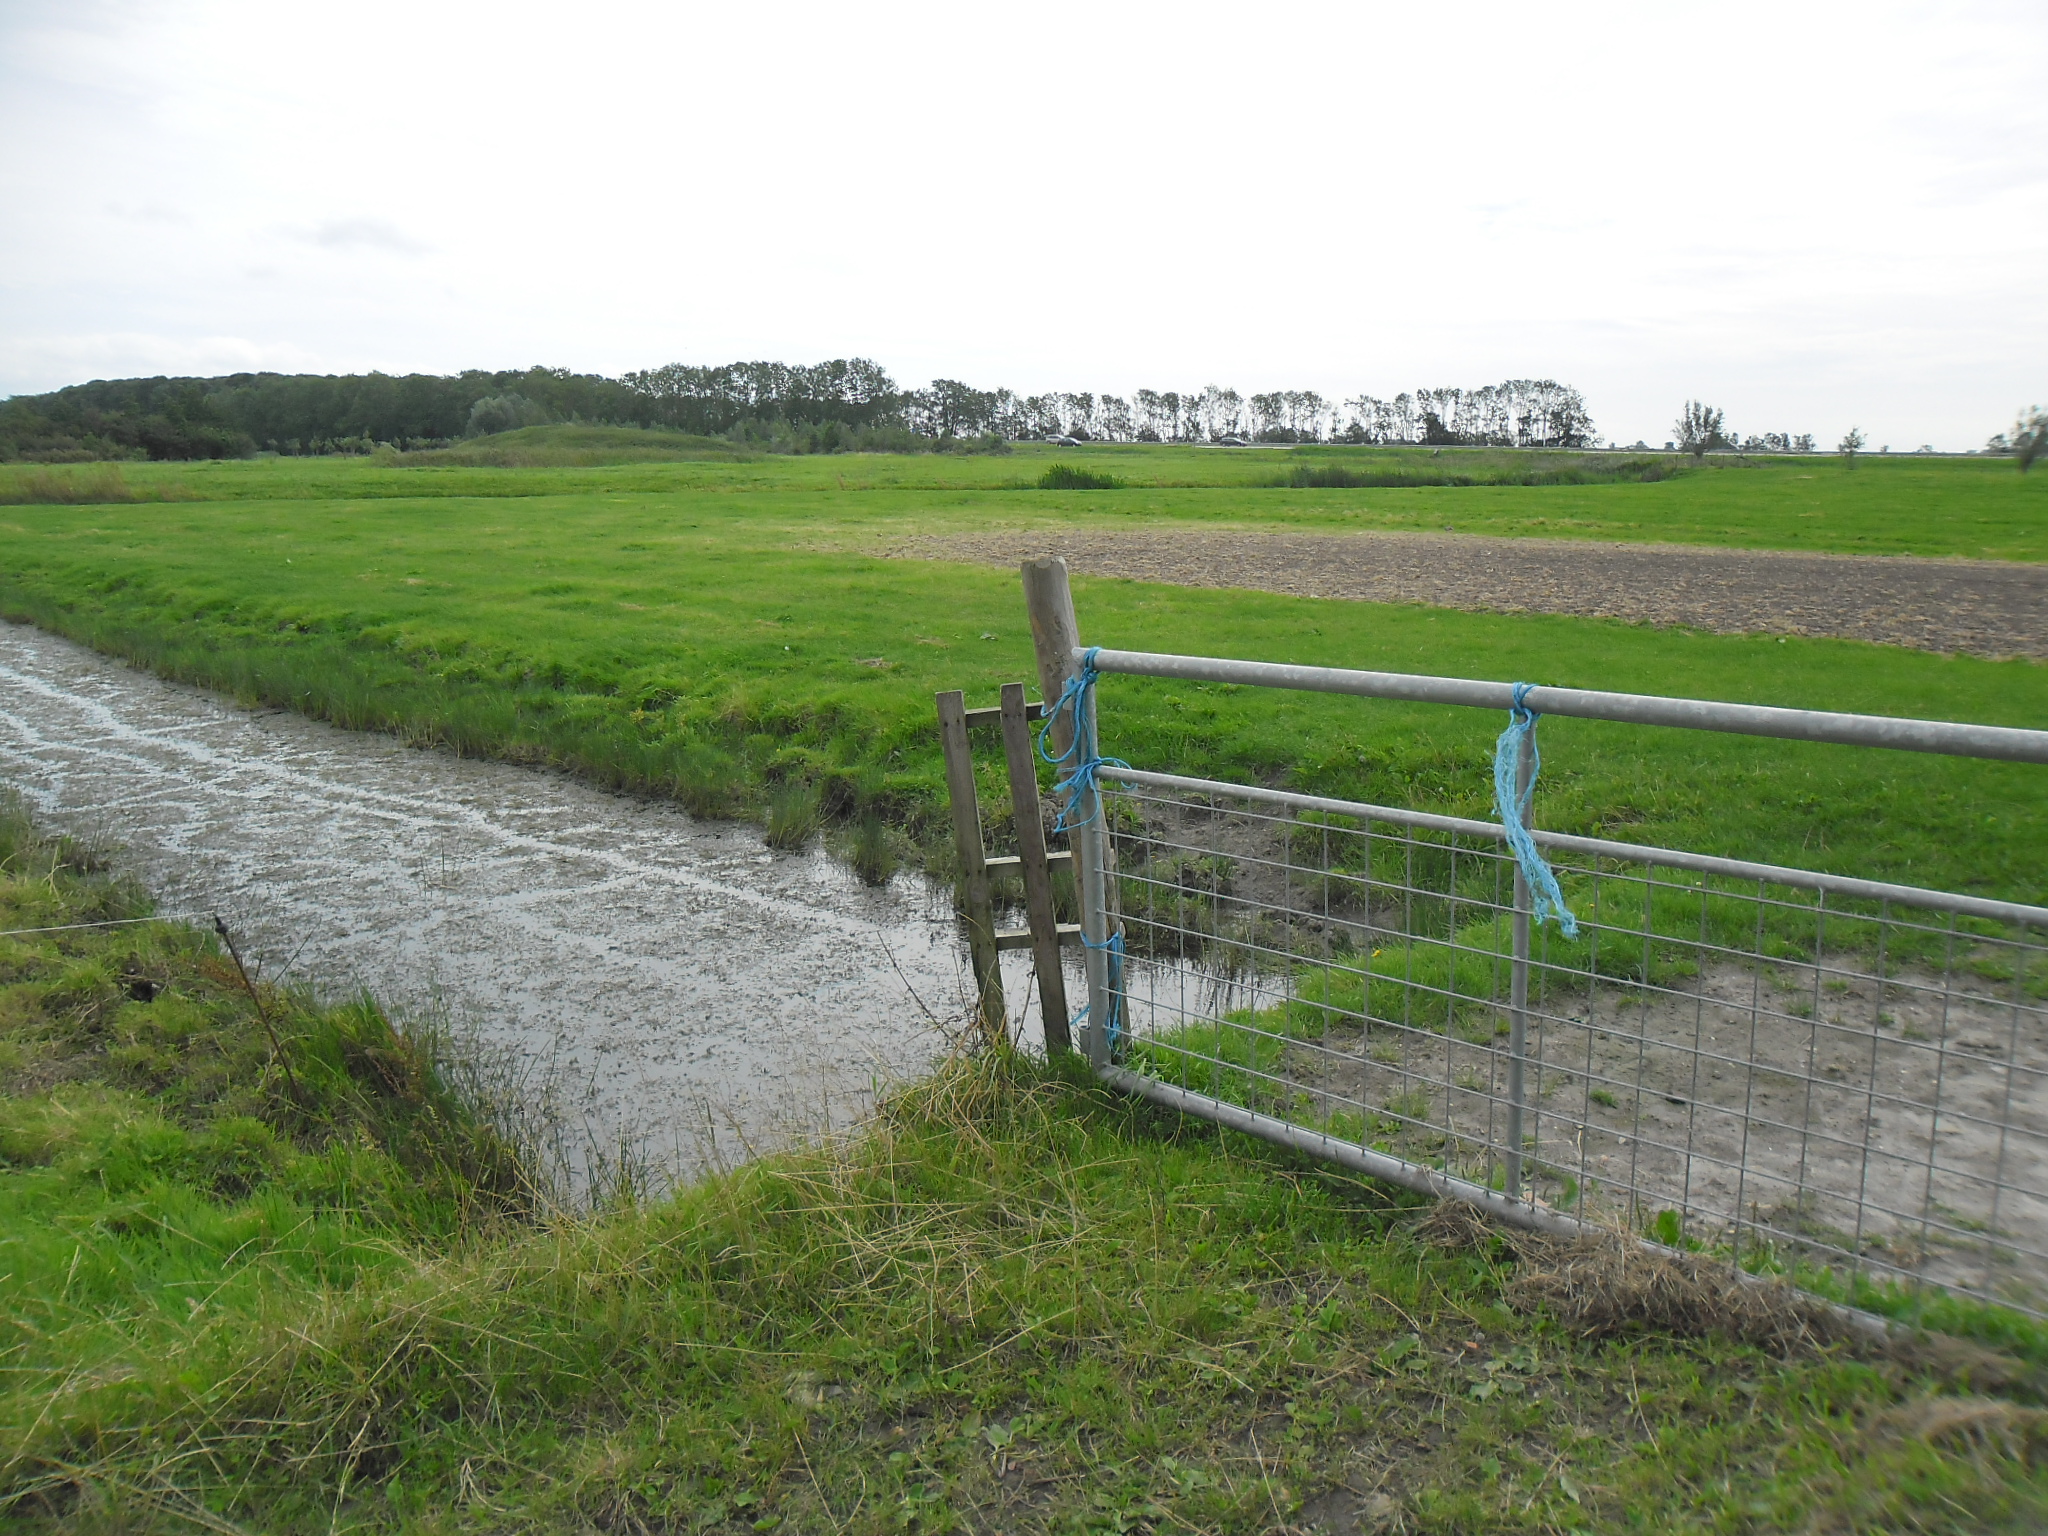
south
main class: Grassland
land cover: Grassland without tree/shrub cover
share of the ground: > 75 %
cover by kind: herbaceous plants 100 %
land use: Agriculture (excluding fallow land and kitchen gardens)
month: August
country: NL
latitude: 53.0509
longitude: 5.5681
